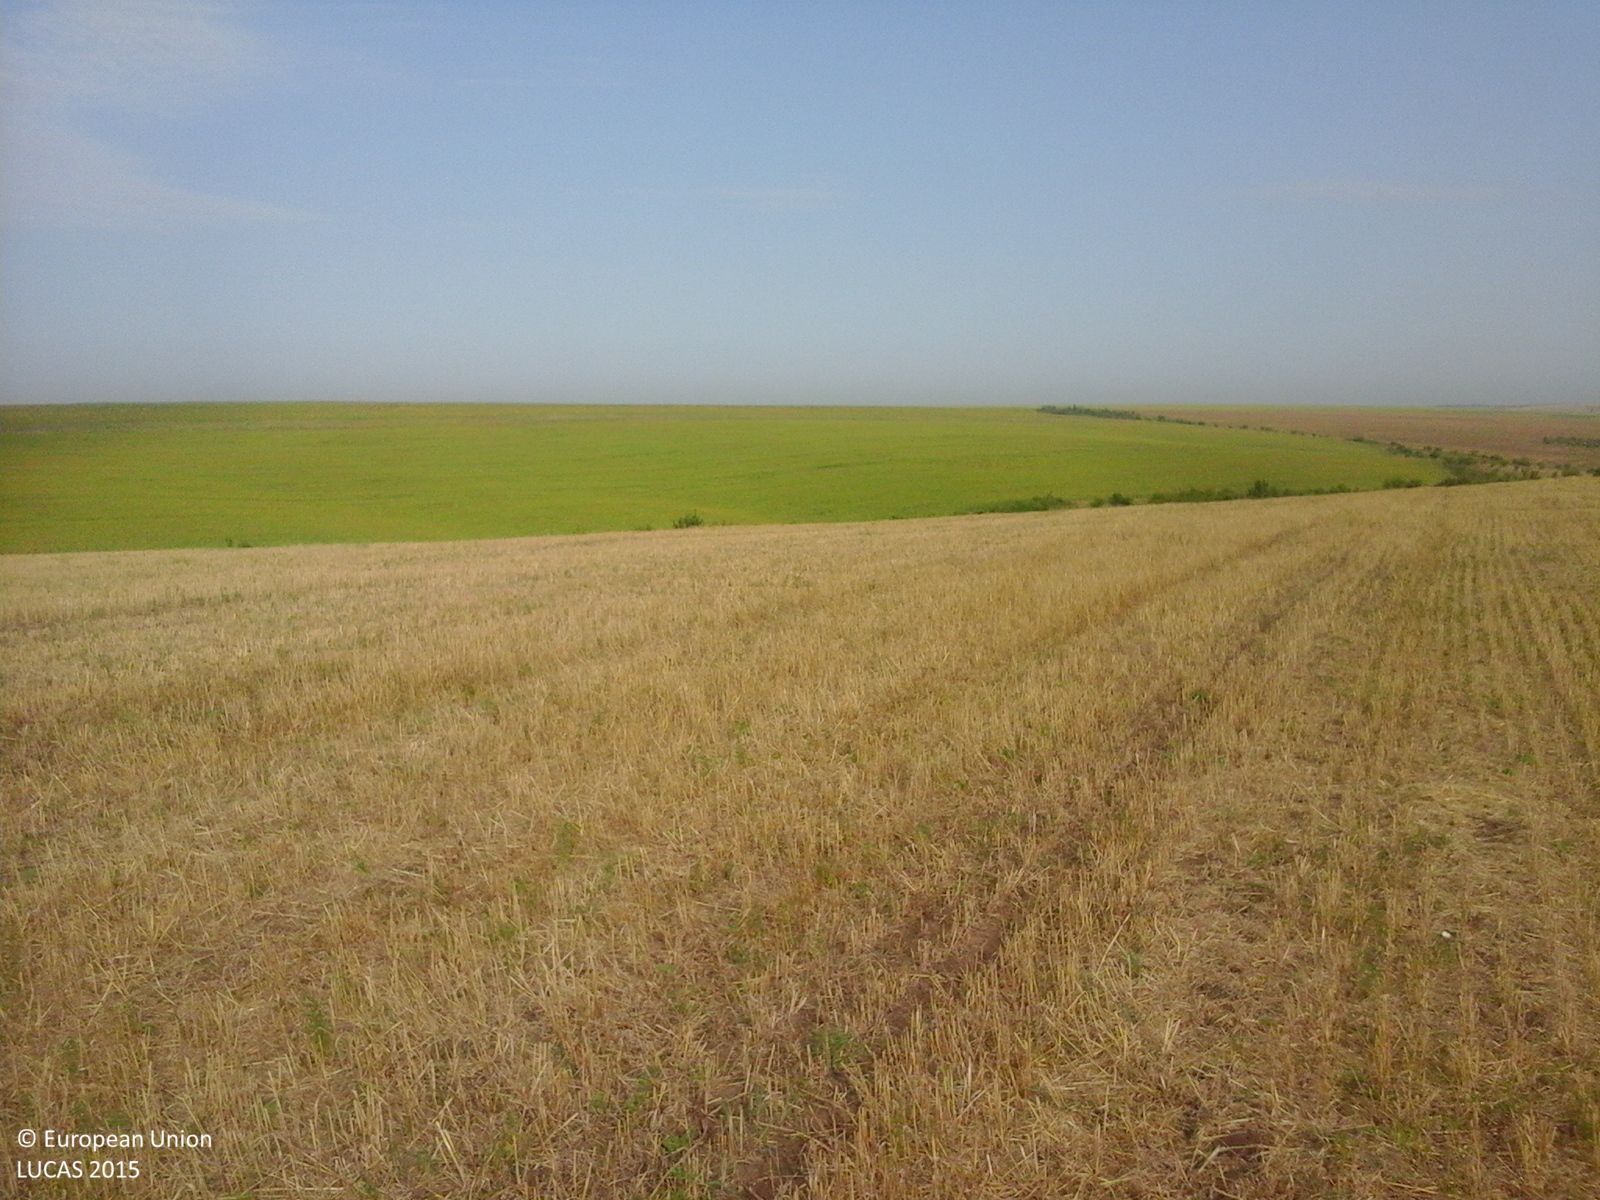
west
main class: Cropland
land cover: Barley
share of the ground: 50 - 75 %
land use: Agriculture (excluding fallow land and kitchen gardens)
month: August
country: RO
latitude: 44.0316
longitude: 27.9049
